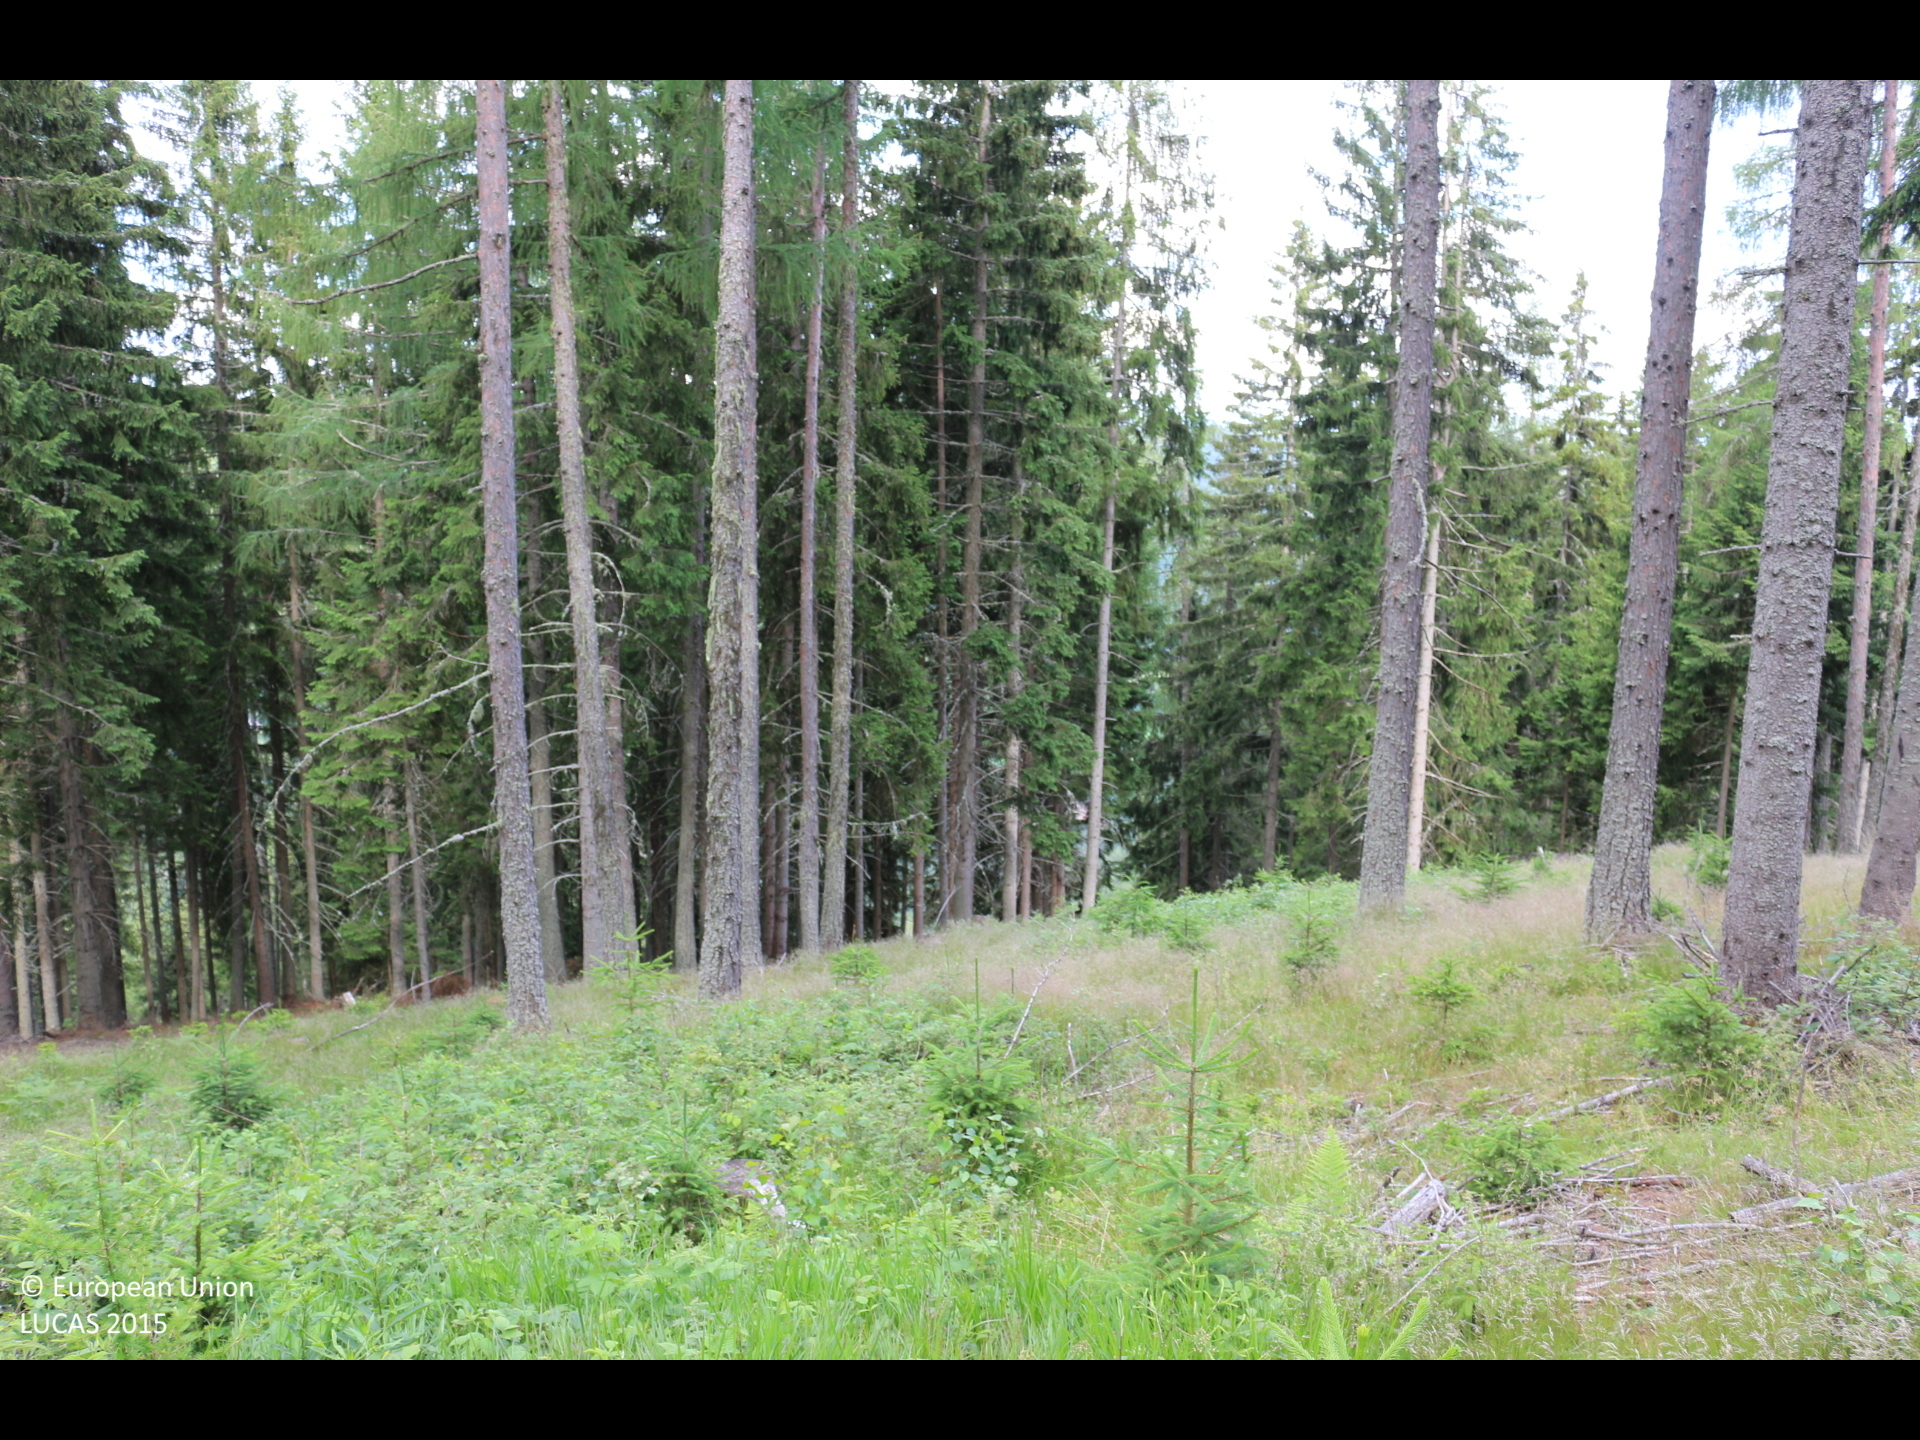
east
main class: Woodland
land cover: Other coniferous woodland
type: alpine coniferous forest
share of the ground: 25 - 50 %
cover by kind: herbaceous plants 60 %, coniferous forest trees 30 %, shrubs 10 %
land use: Forestry
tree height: > 5 m
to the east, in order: Other coniferous woodland; Tracks; Grass margins; Other mixed woodland; Spruce dominated coniferous woodland; Tracks; Spruce dominated coniferous woodland
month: June
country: AT
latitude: 46.9025
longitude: 14.1329
